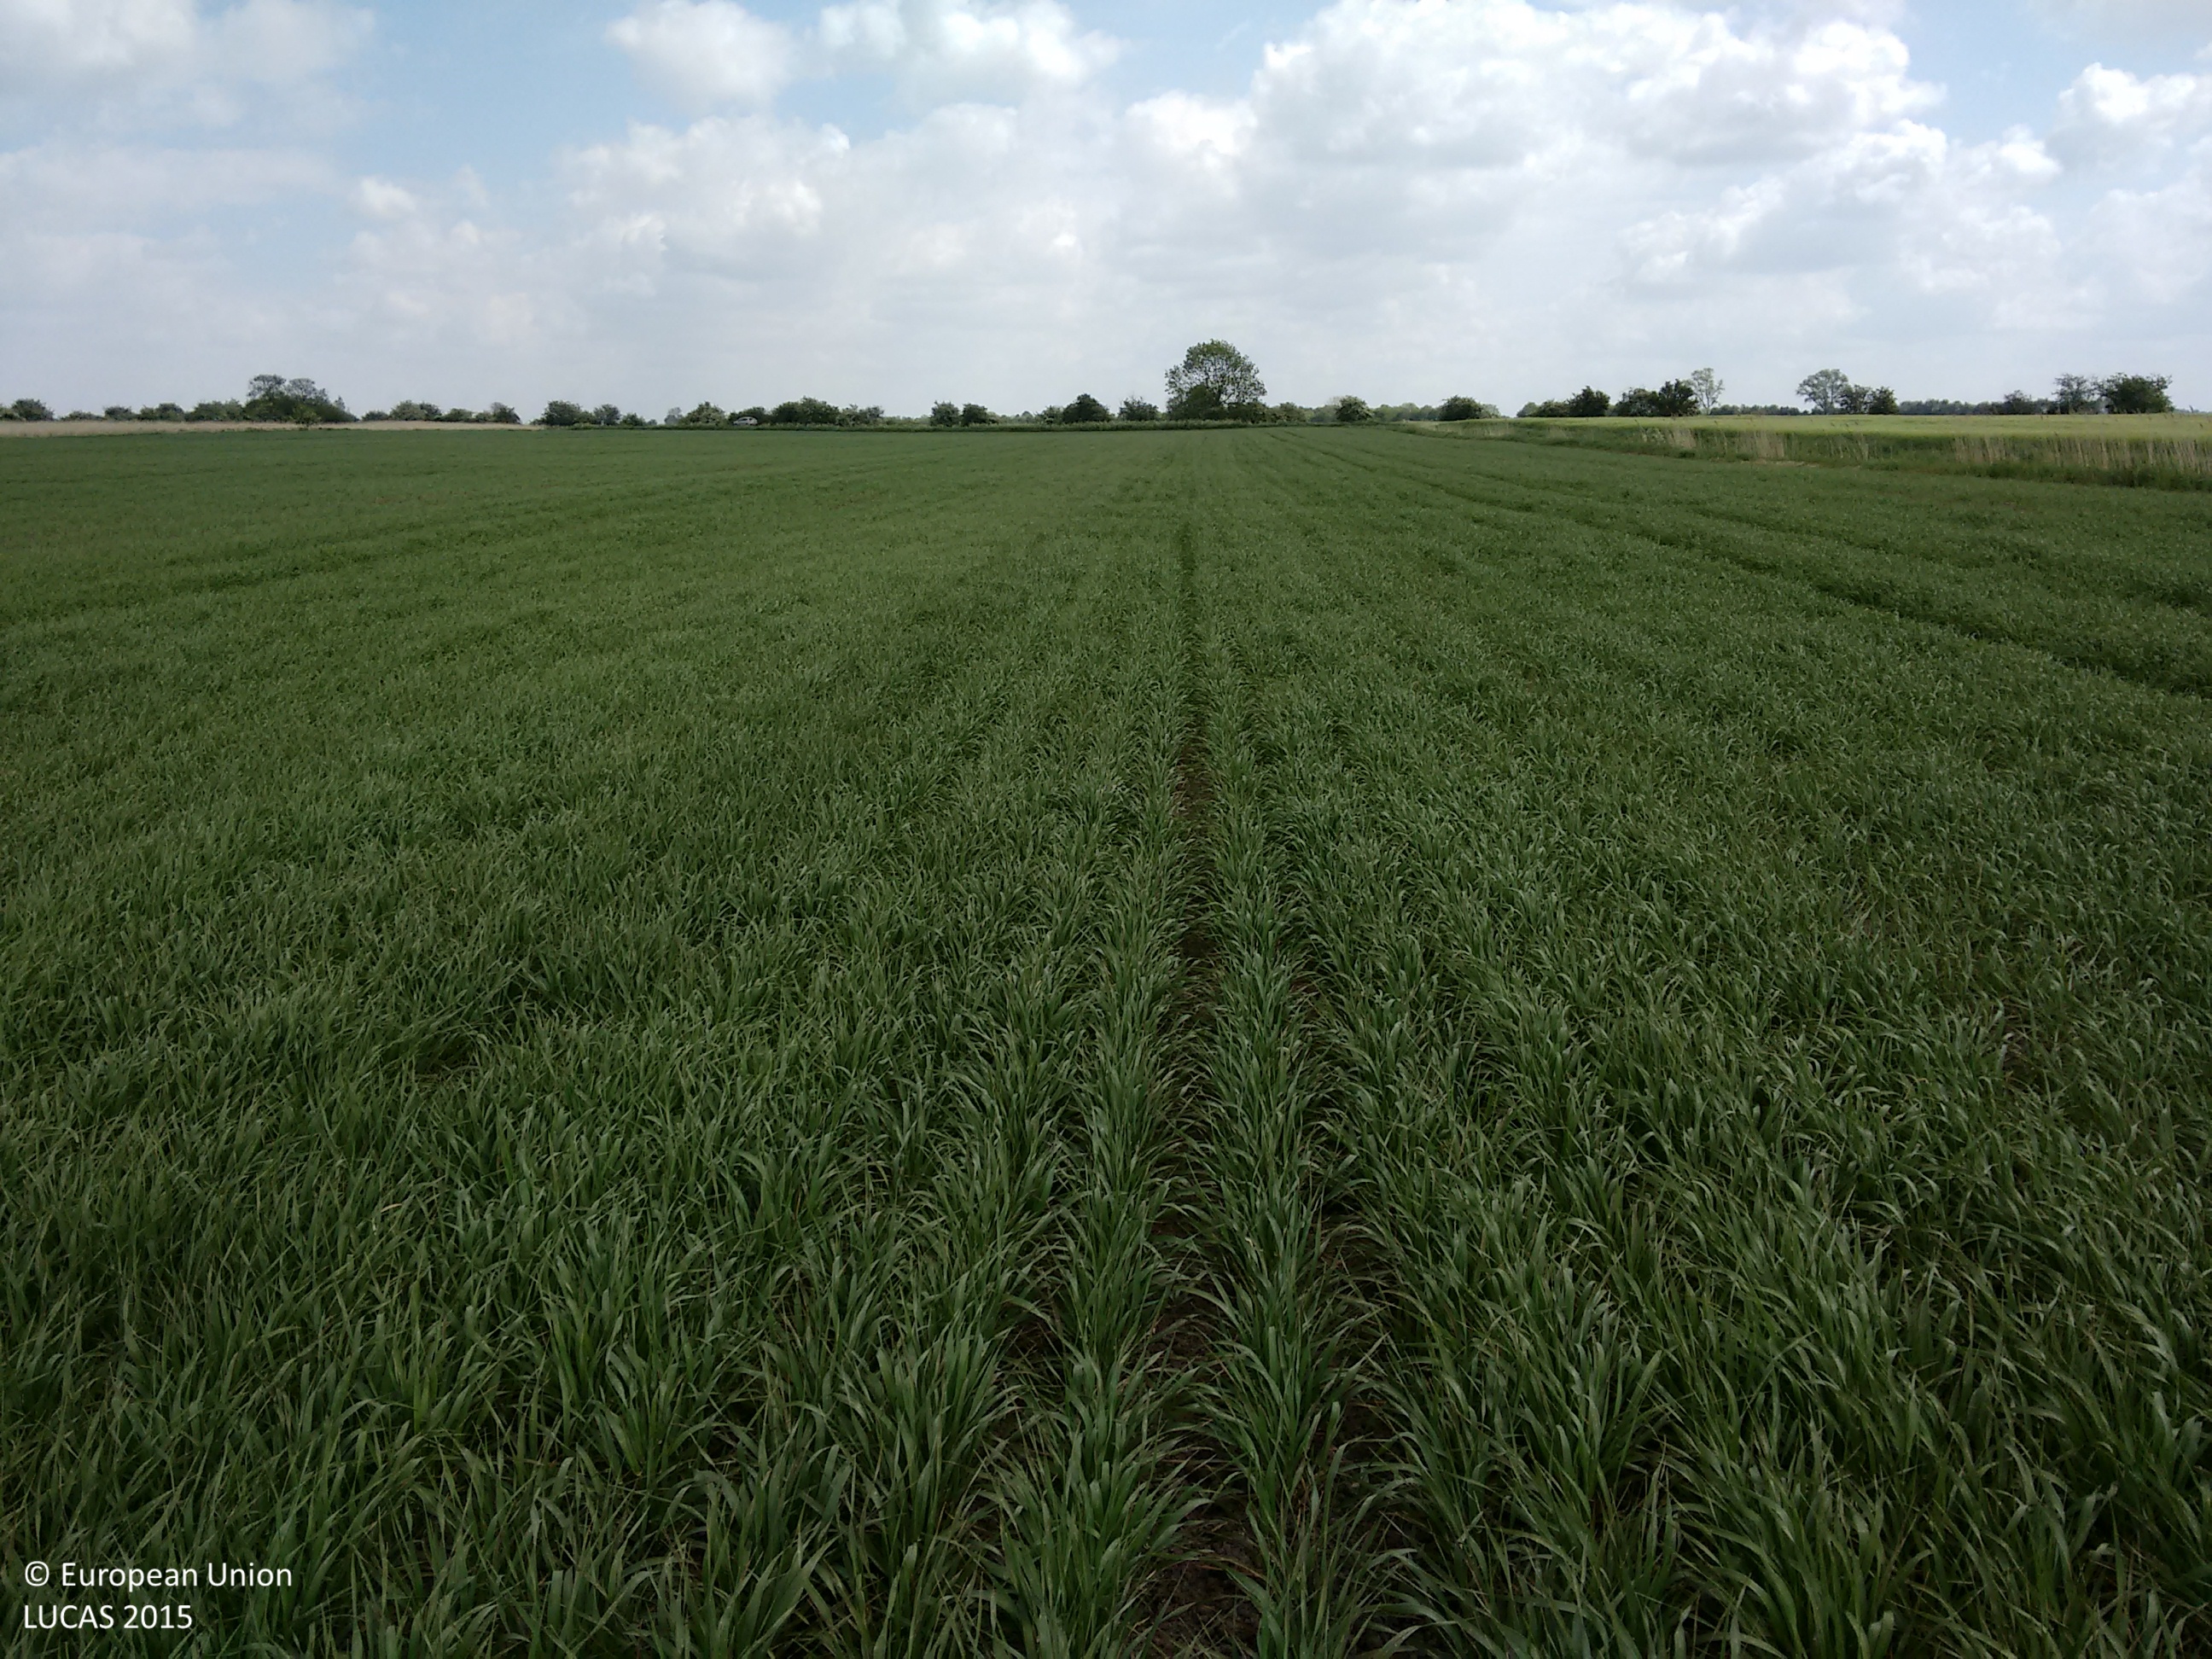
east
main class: Cropland
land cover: Barley
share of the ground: > 75 %
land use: Agriculture (excluding fallow land and kitchen gardens)
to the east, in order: Barley; Grass margins; Ditches and canals; Grass margins; Common wheat; Grass margins; Ditches and canals; Grass margins; Paved roads, cycling and walking lanes; Grass margins; Ditches and canals; Grass margins; Barley
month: May
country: GB
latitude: 52.7132
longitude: -0.0244
